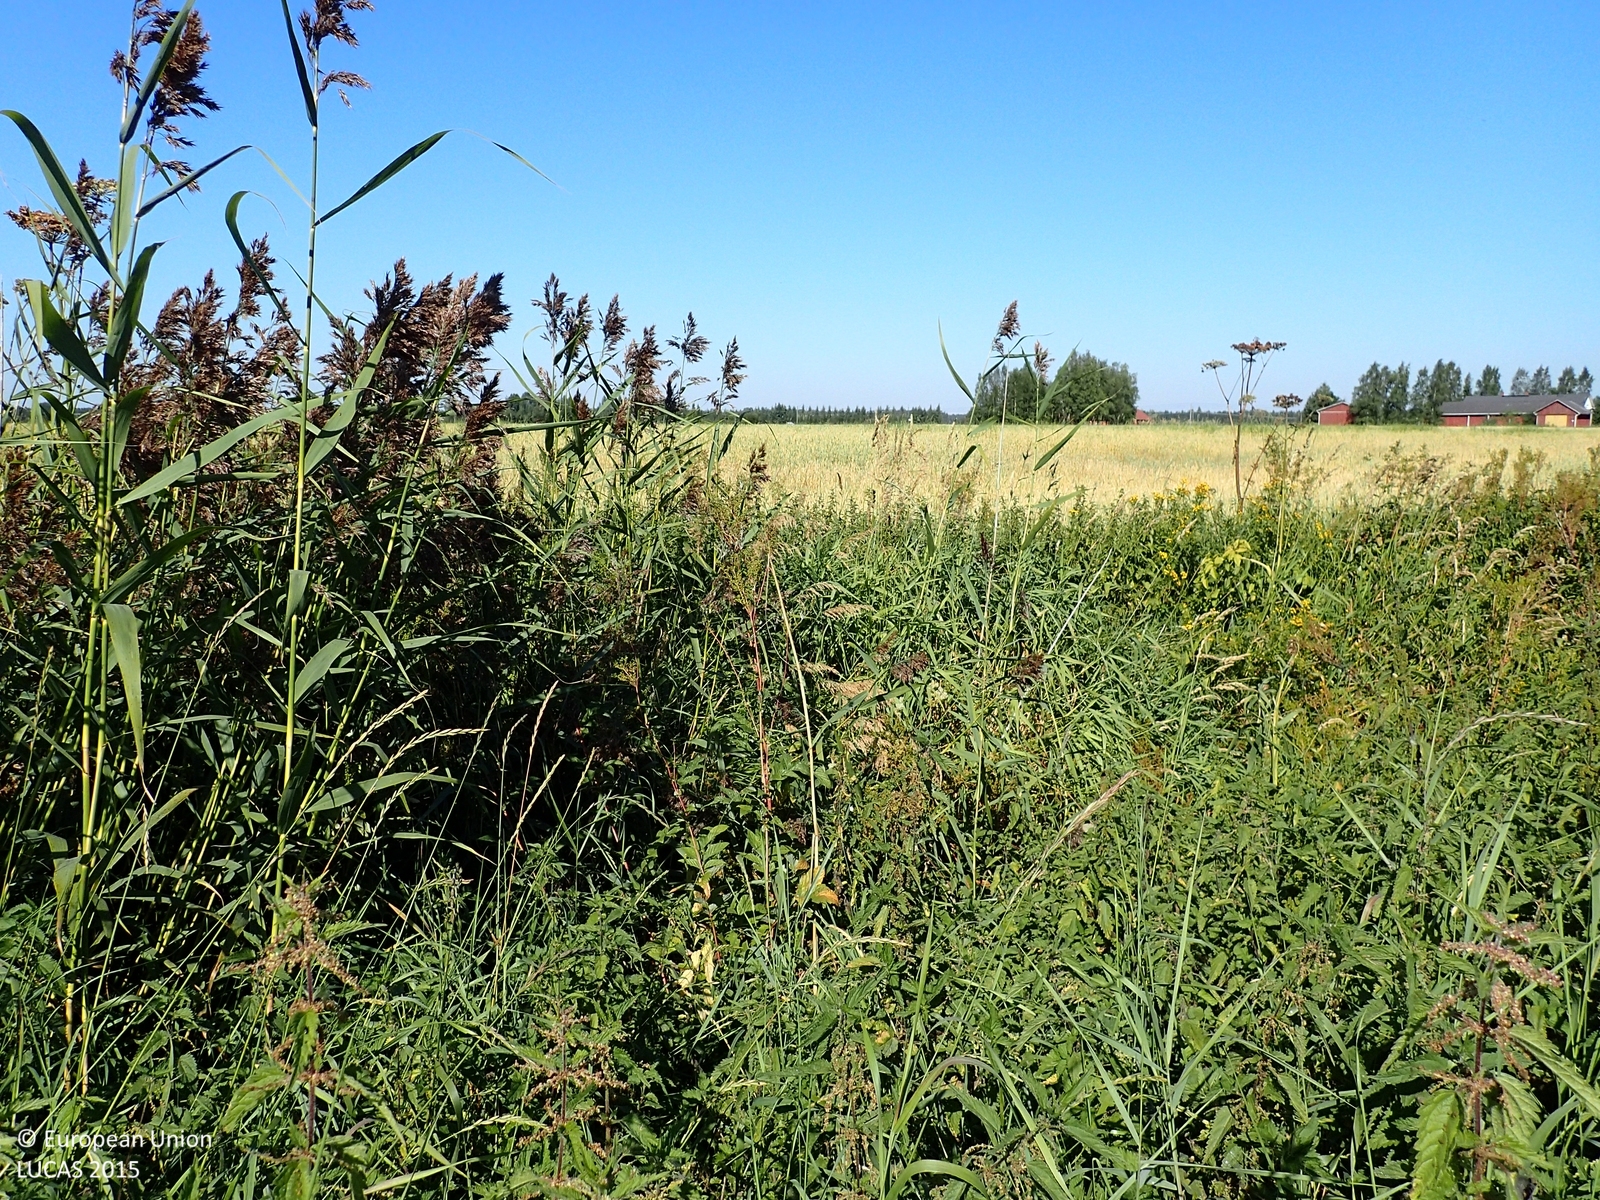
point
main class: Cropland
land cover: Common wheat
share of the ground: > 75 %
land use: Agriculture (excluding fallow land and kitchen gardens)
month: August
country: FI
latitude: 62.4652
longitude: 21.6992
